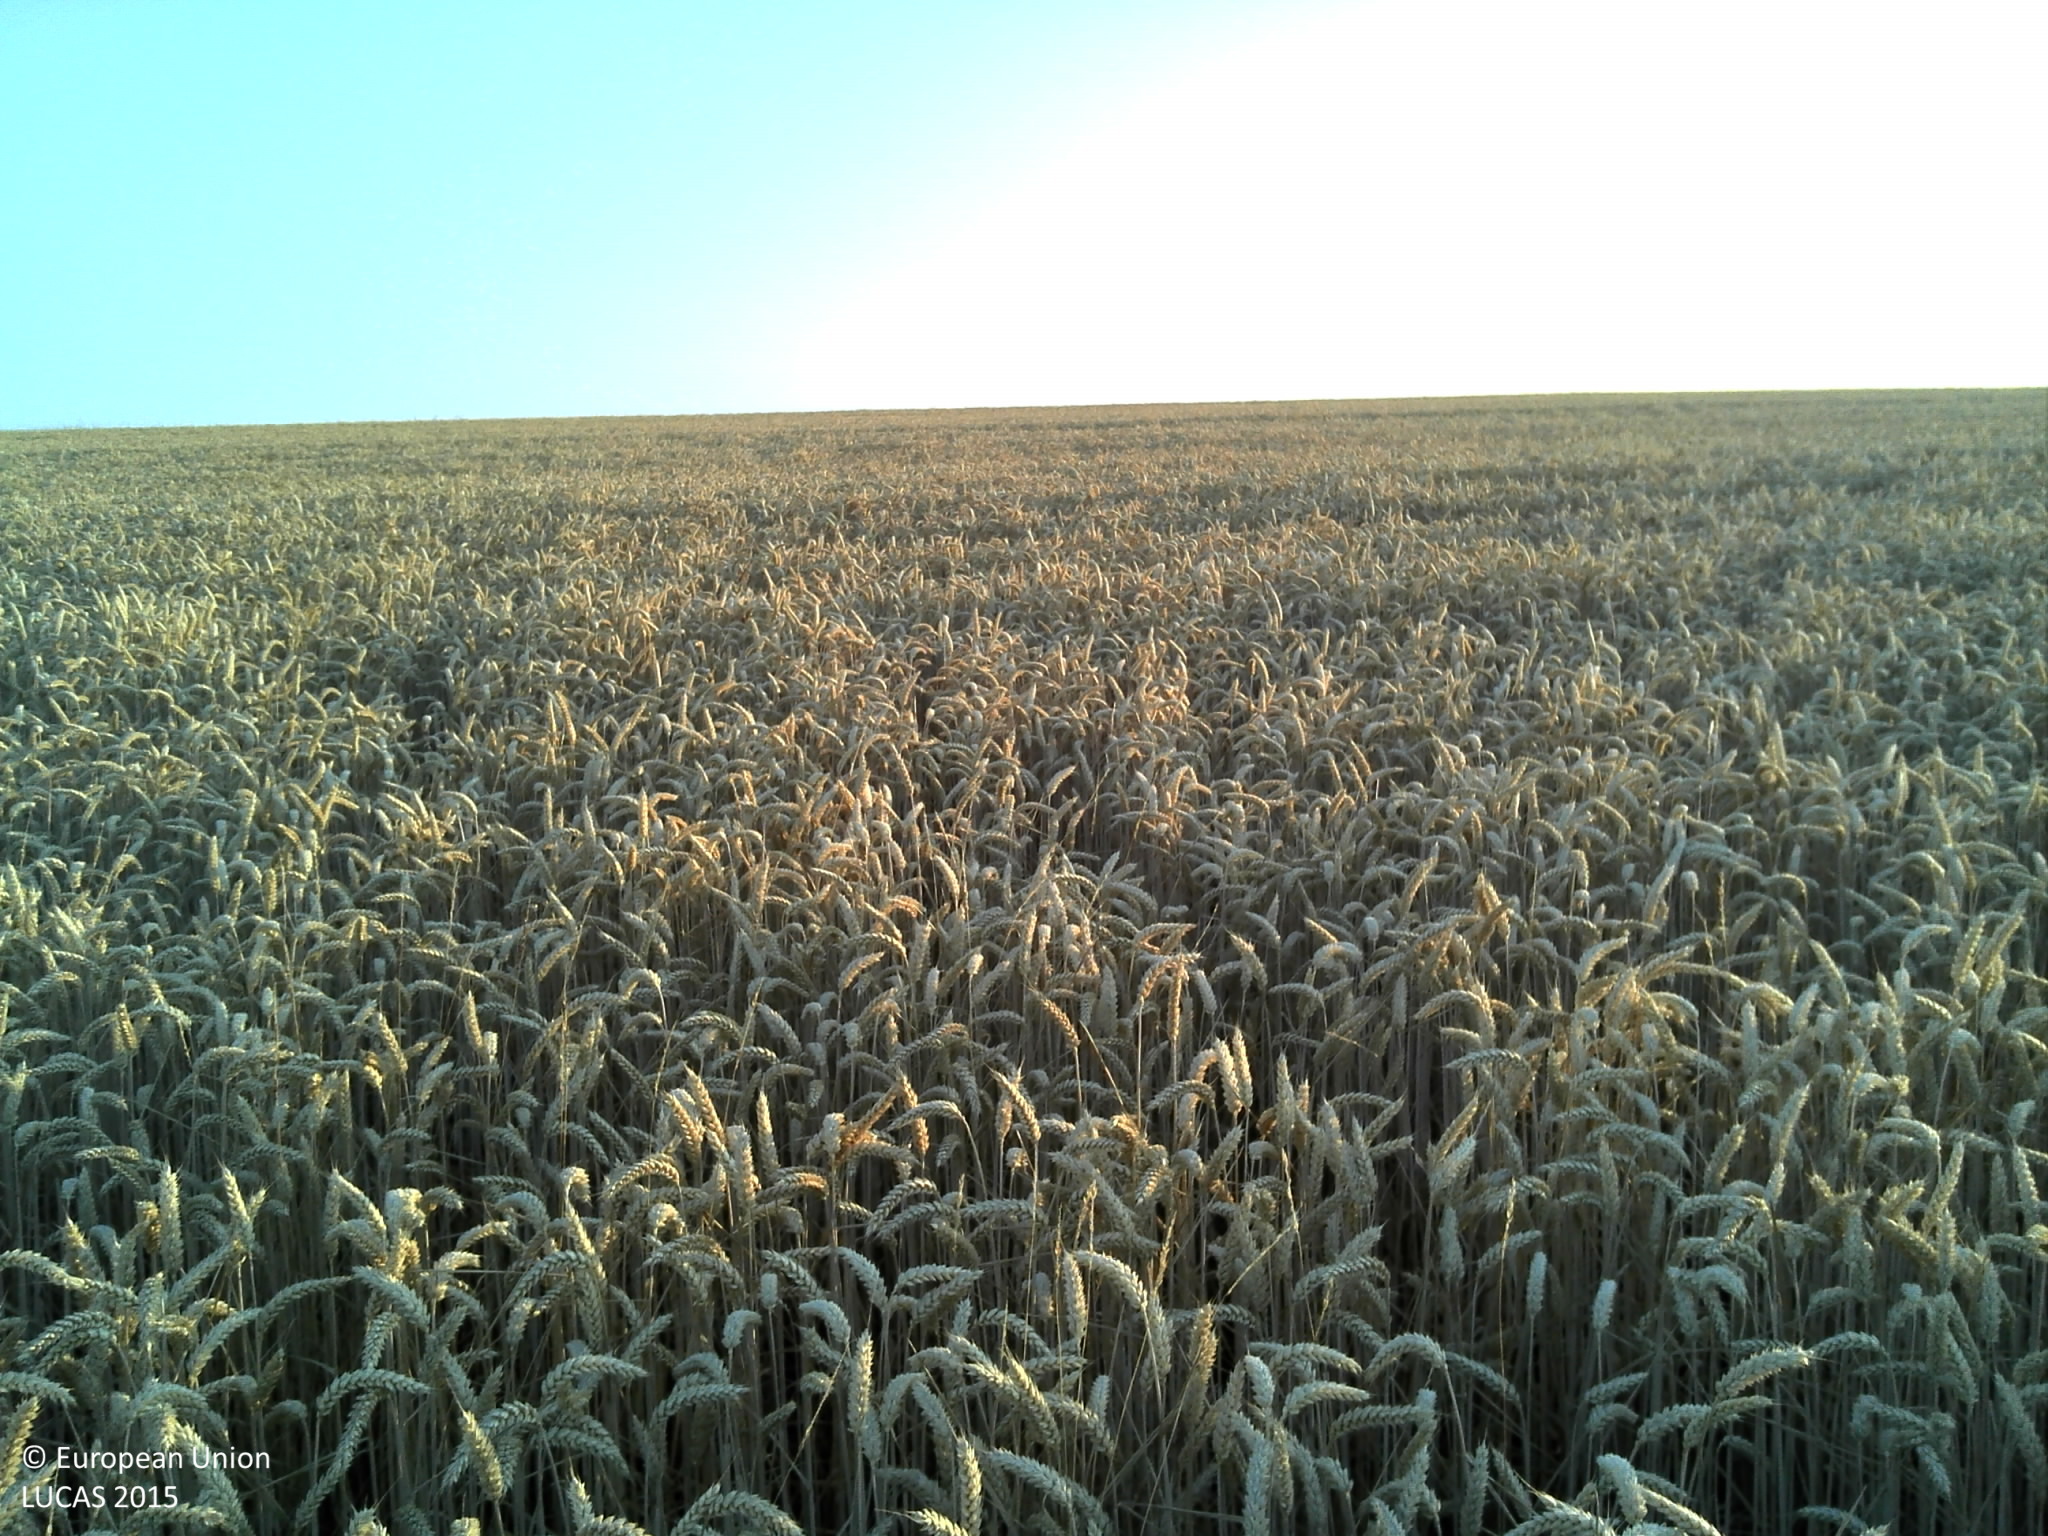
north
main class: Cropland
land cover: Common wheat
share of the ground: > 75 %
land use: Agriculture (excluding fallow land and kitchen gardens)
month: July
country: FR
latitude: 48.1911
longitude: 6.1128
